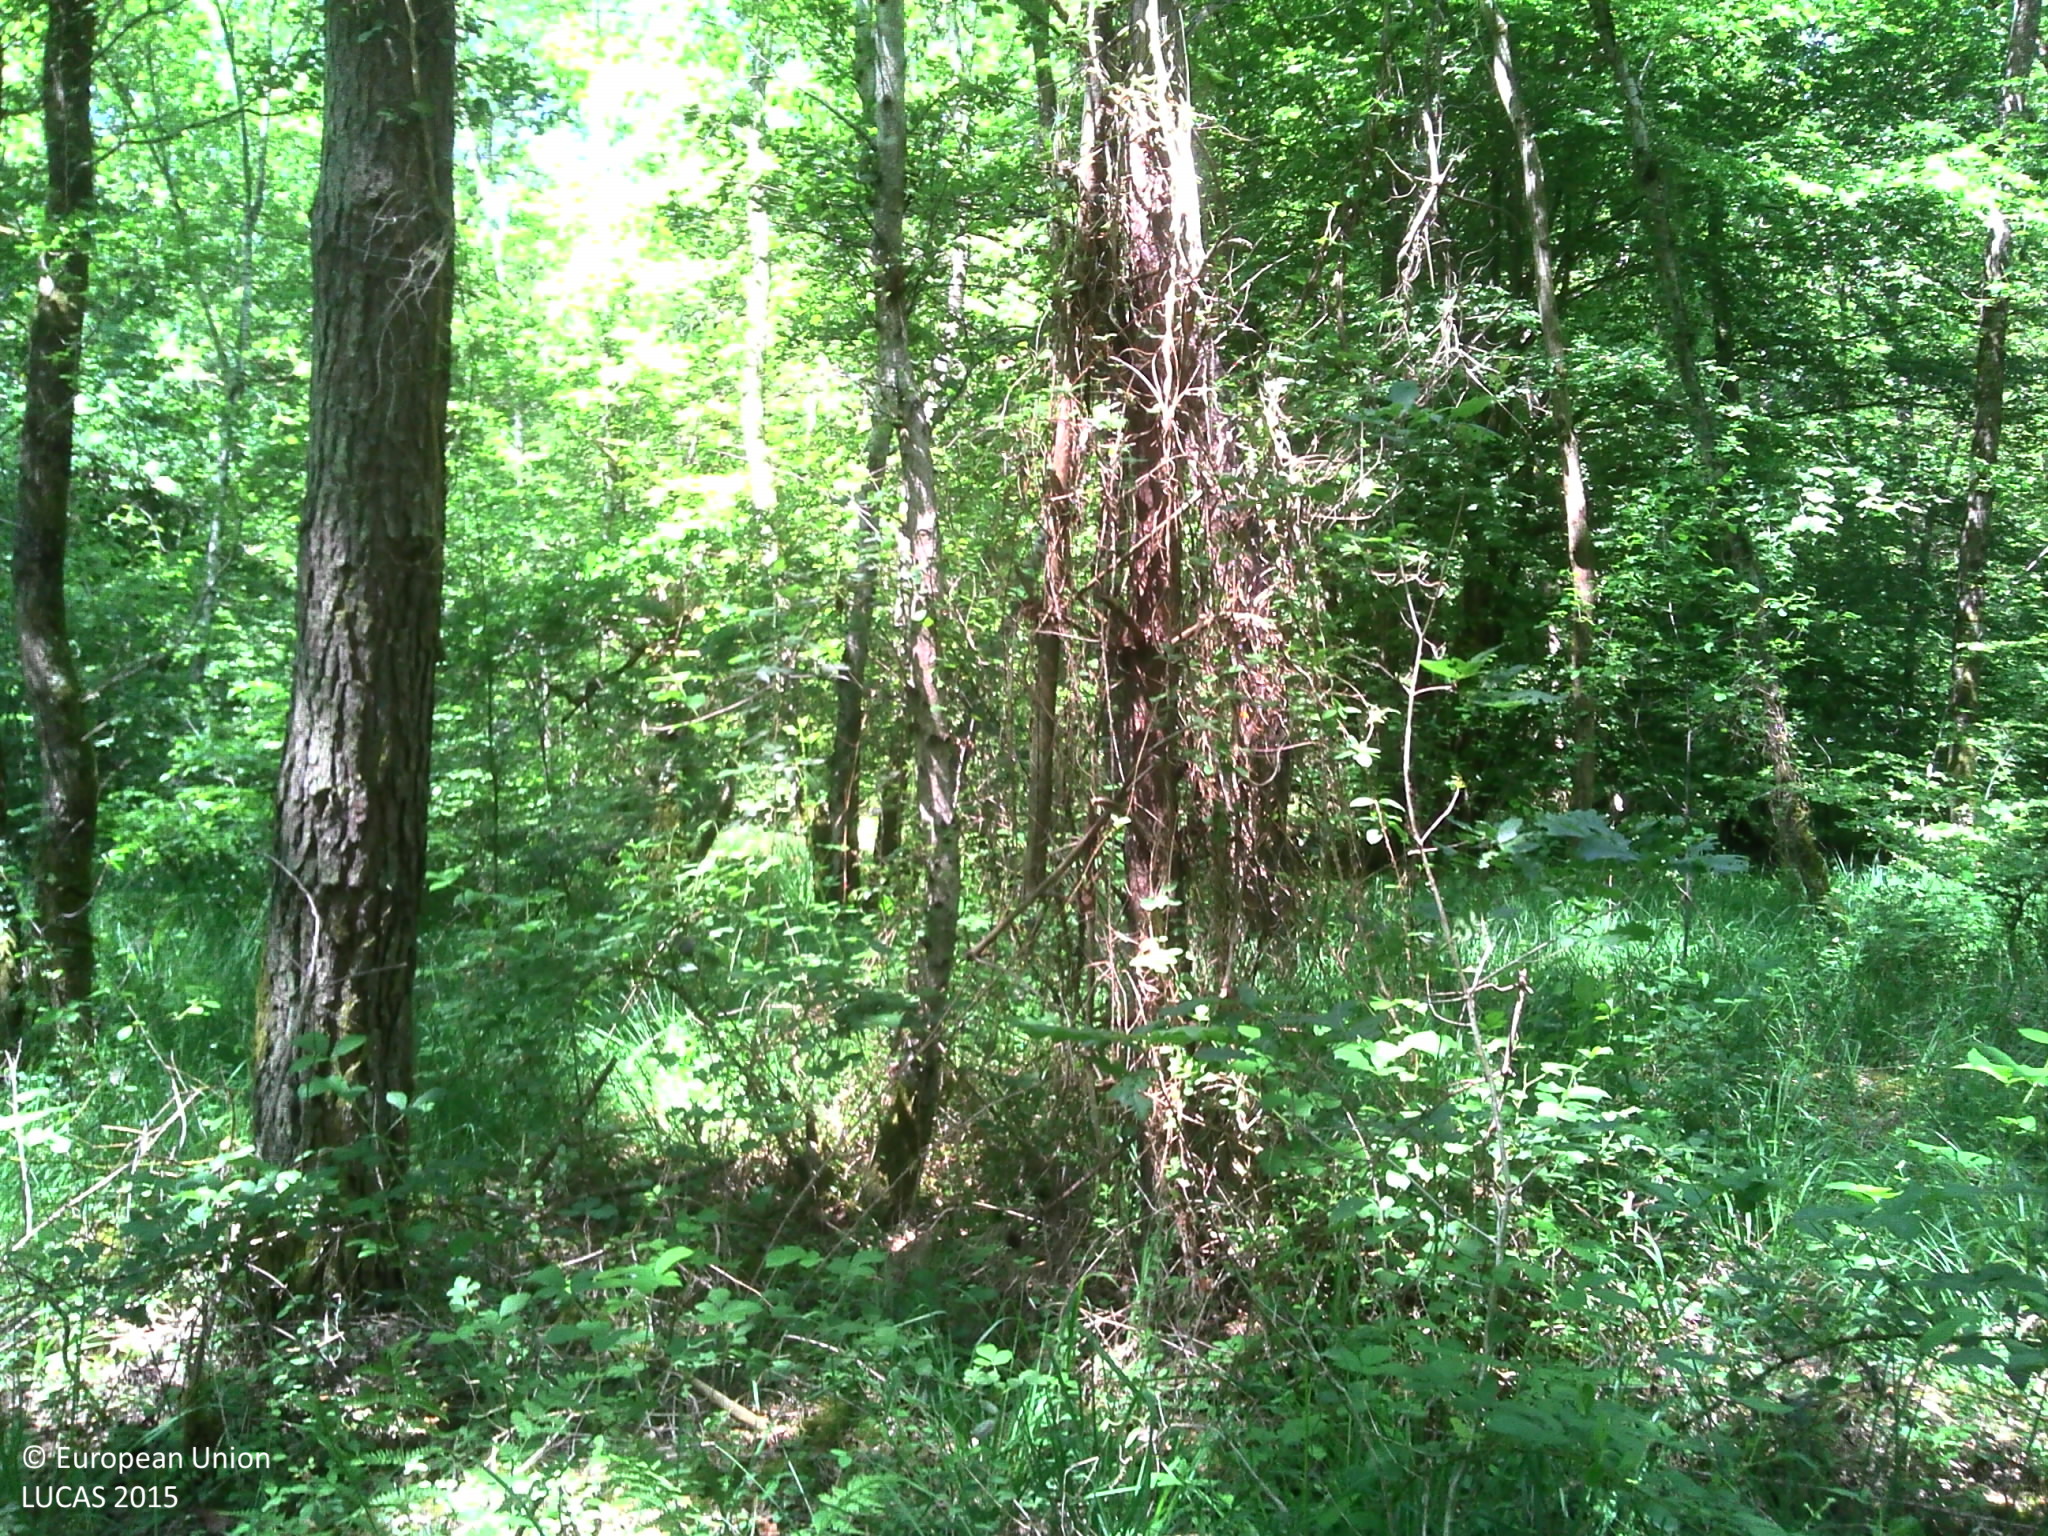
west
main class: Woodland
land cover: Broadleaved woodland
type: thermophilous deciduous forest
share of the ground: > 75 %
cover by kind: broadleaved forest trees 80 %, herbaceous plants 20 %
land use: Forestry
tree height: > 5 m
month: June
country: FR
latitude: 46.6201
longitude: 4.7648
